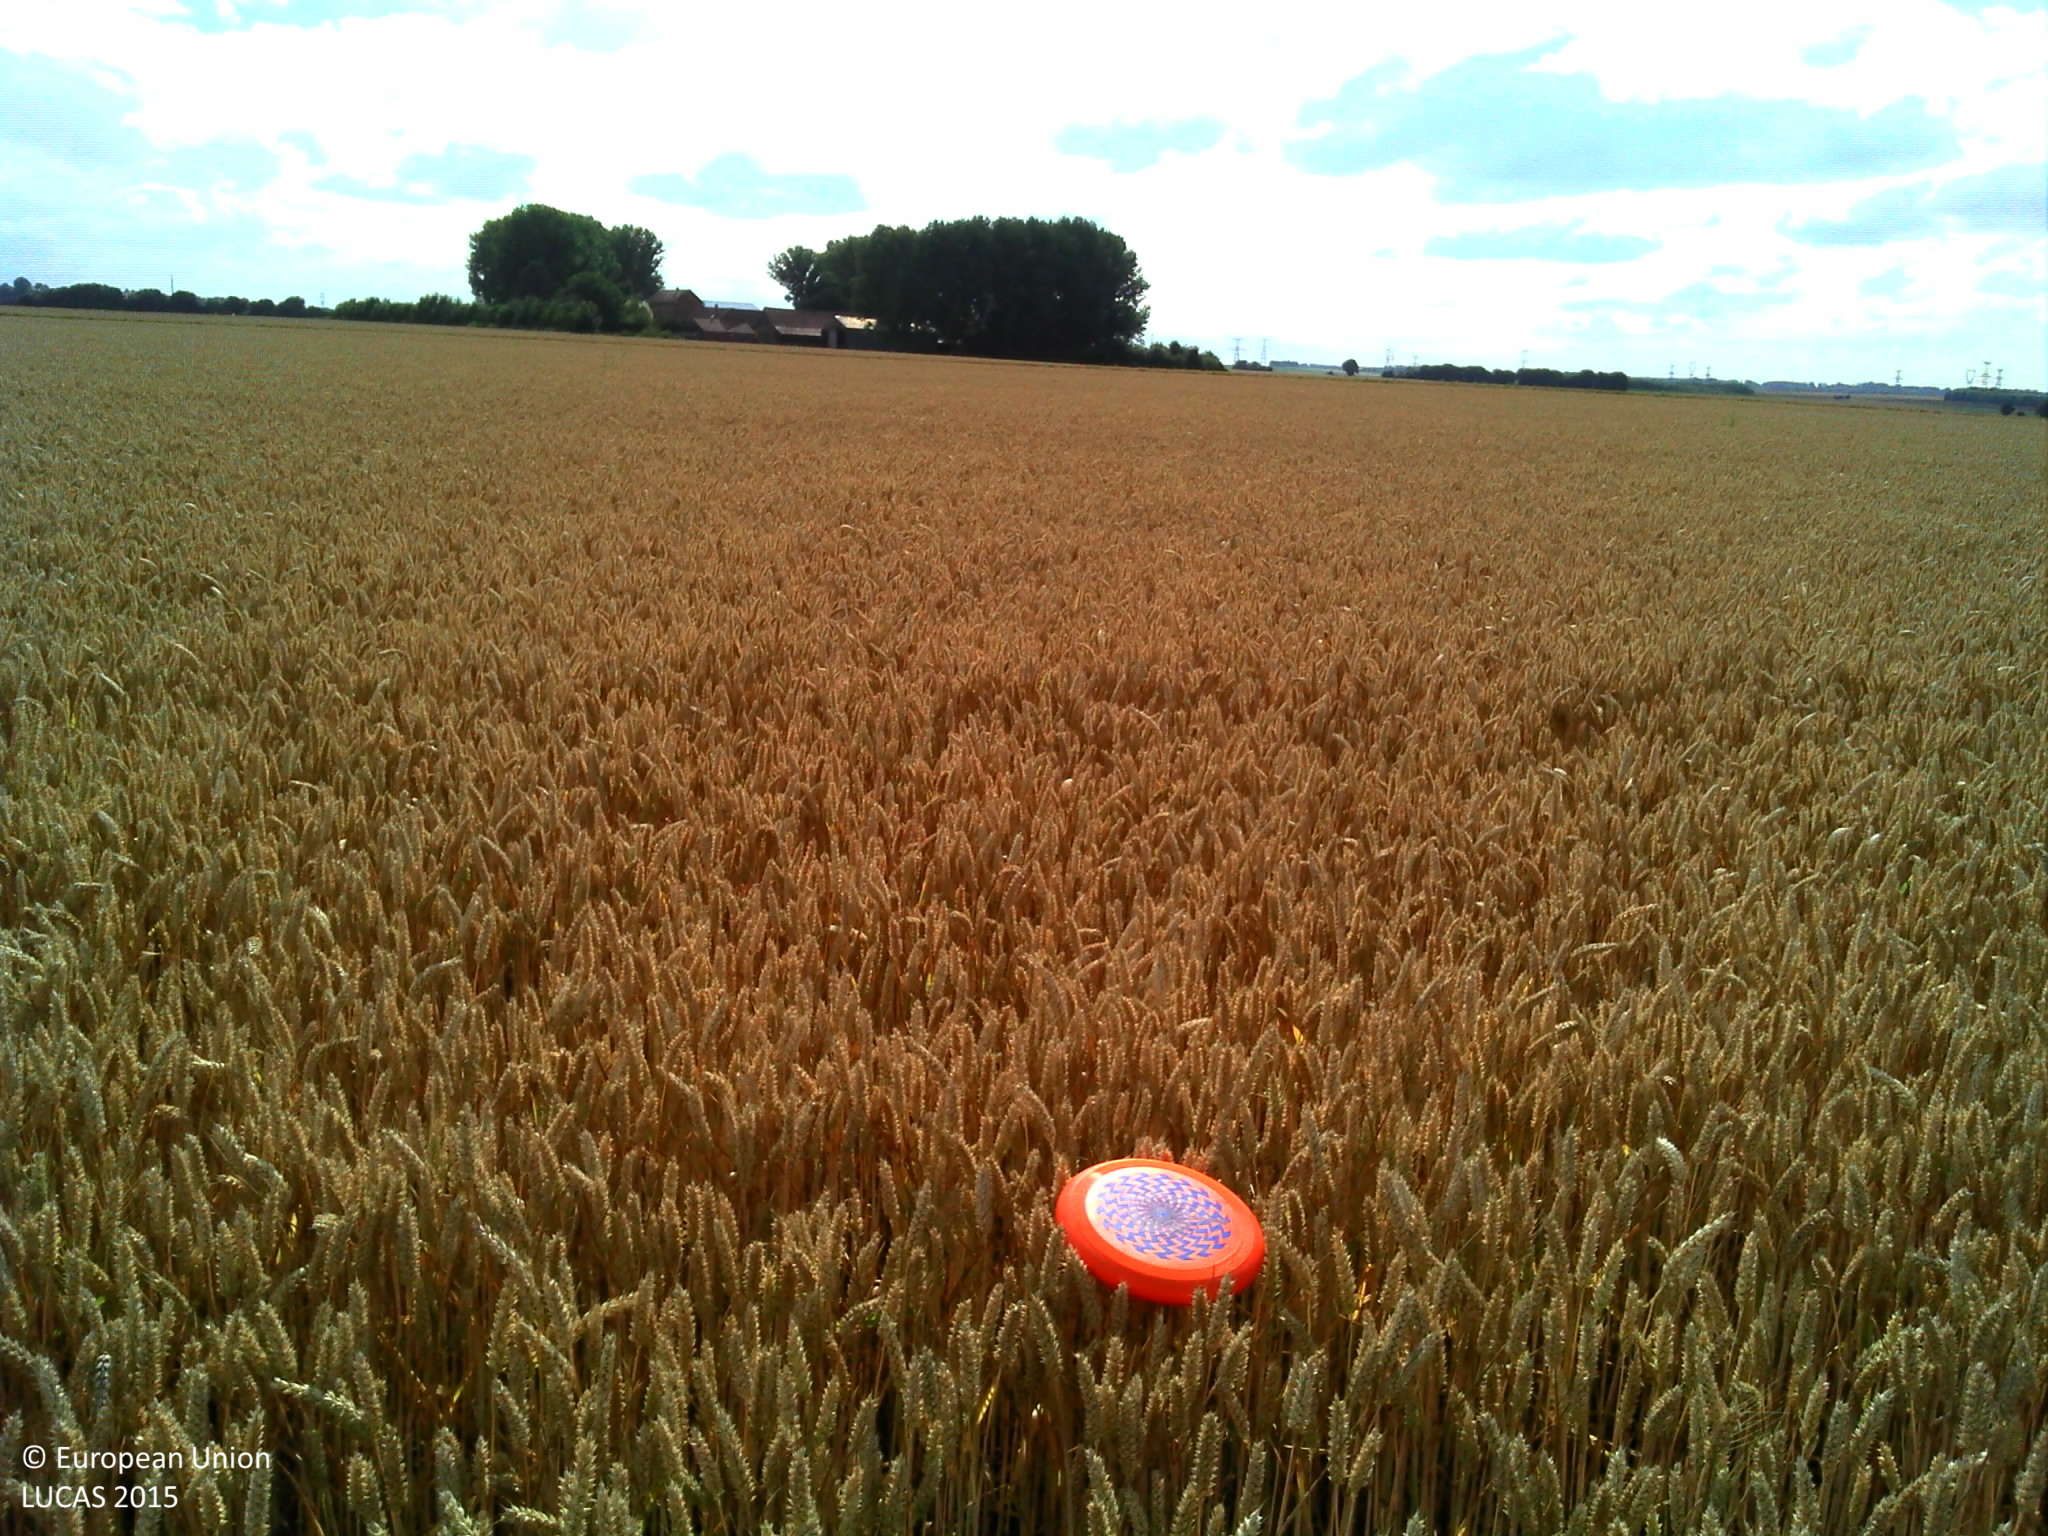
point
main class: Cropland
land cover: Common wheat
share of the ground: > 75 %
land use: Agriculture (excluding fallow land and kitchen gardens)
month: July
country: FR
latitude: 50.1664
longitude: 2.6947
